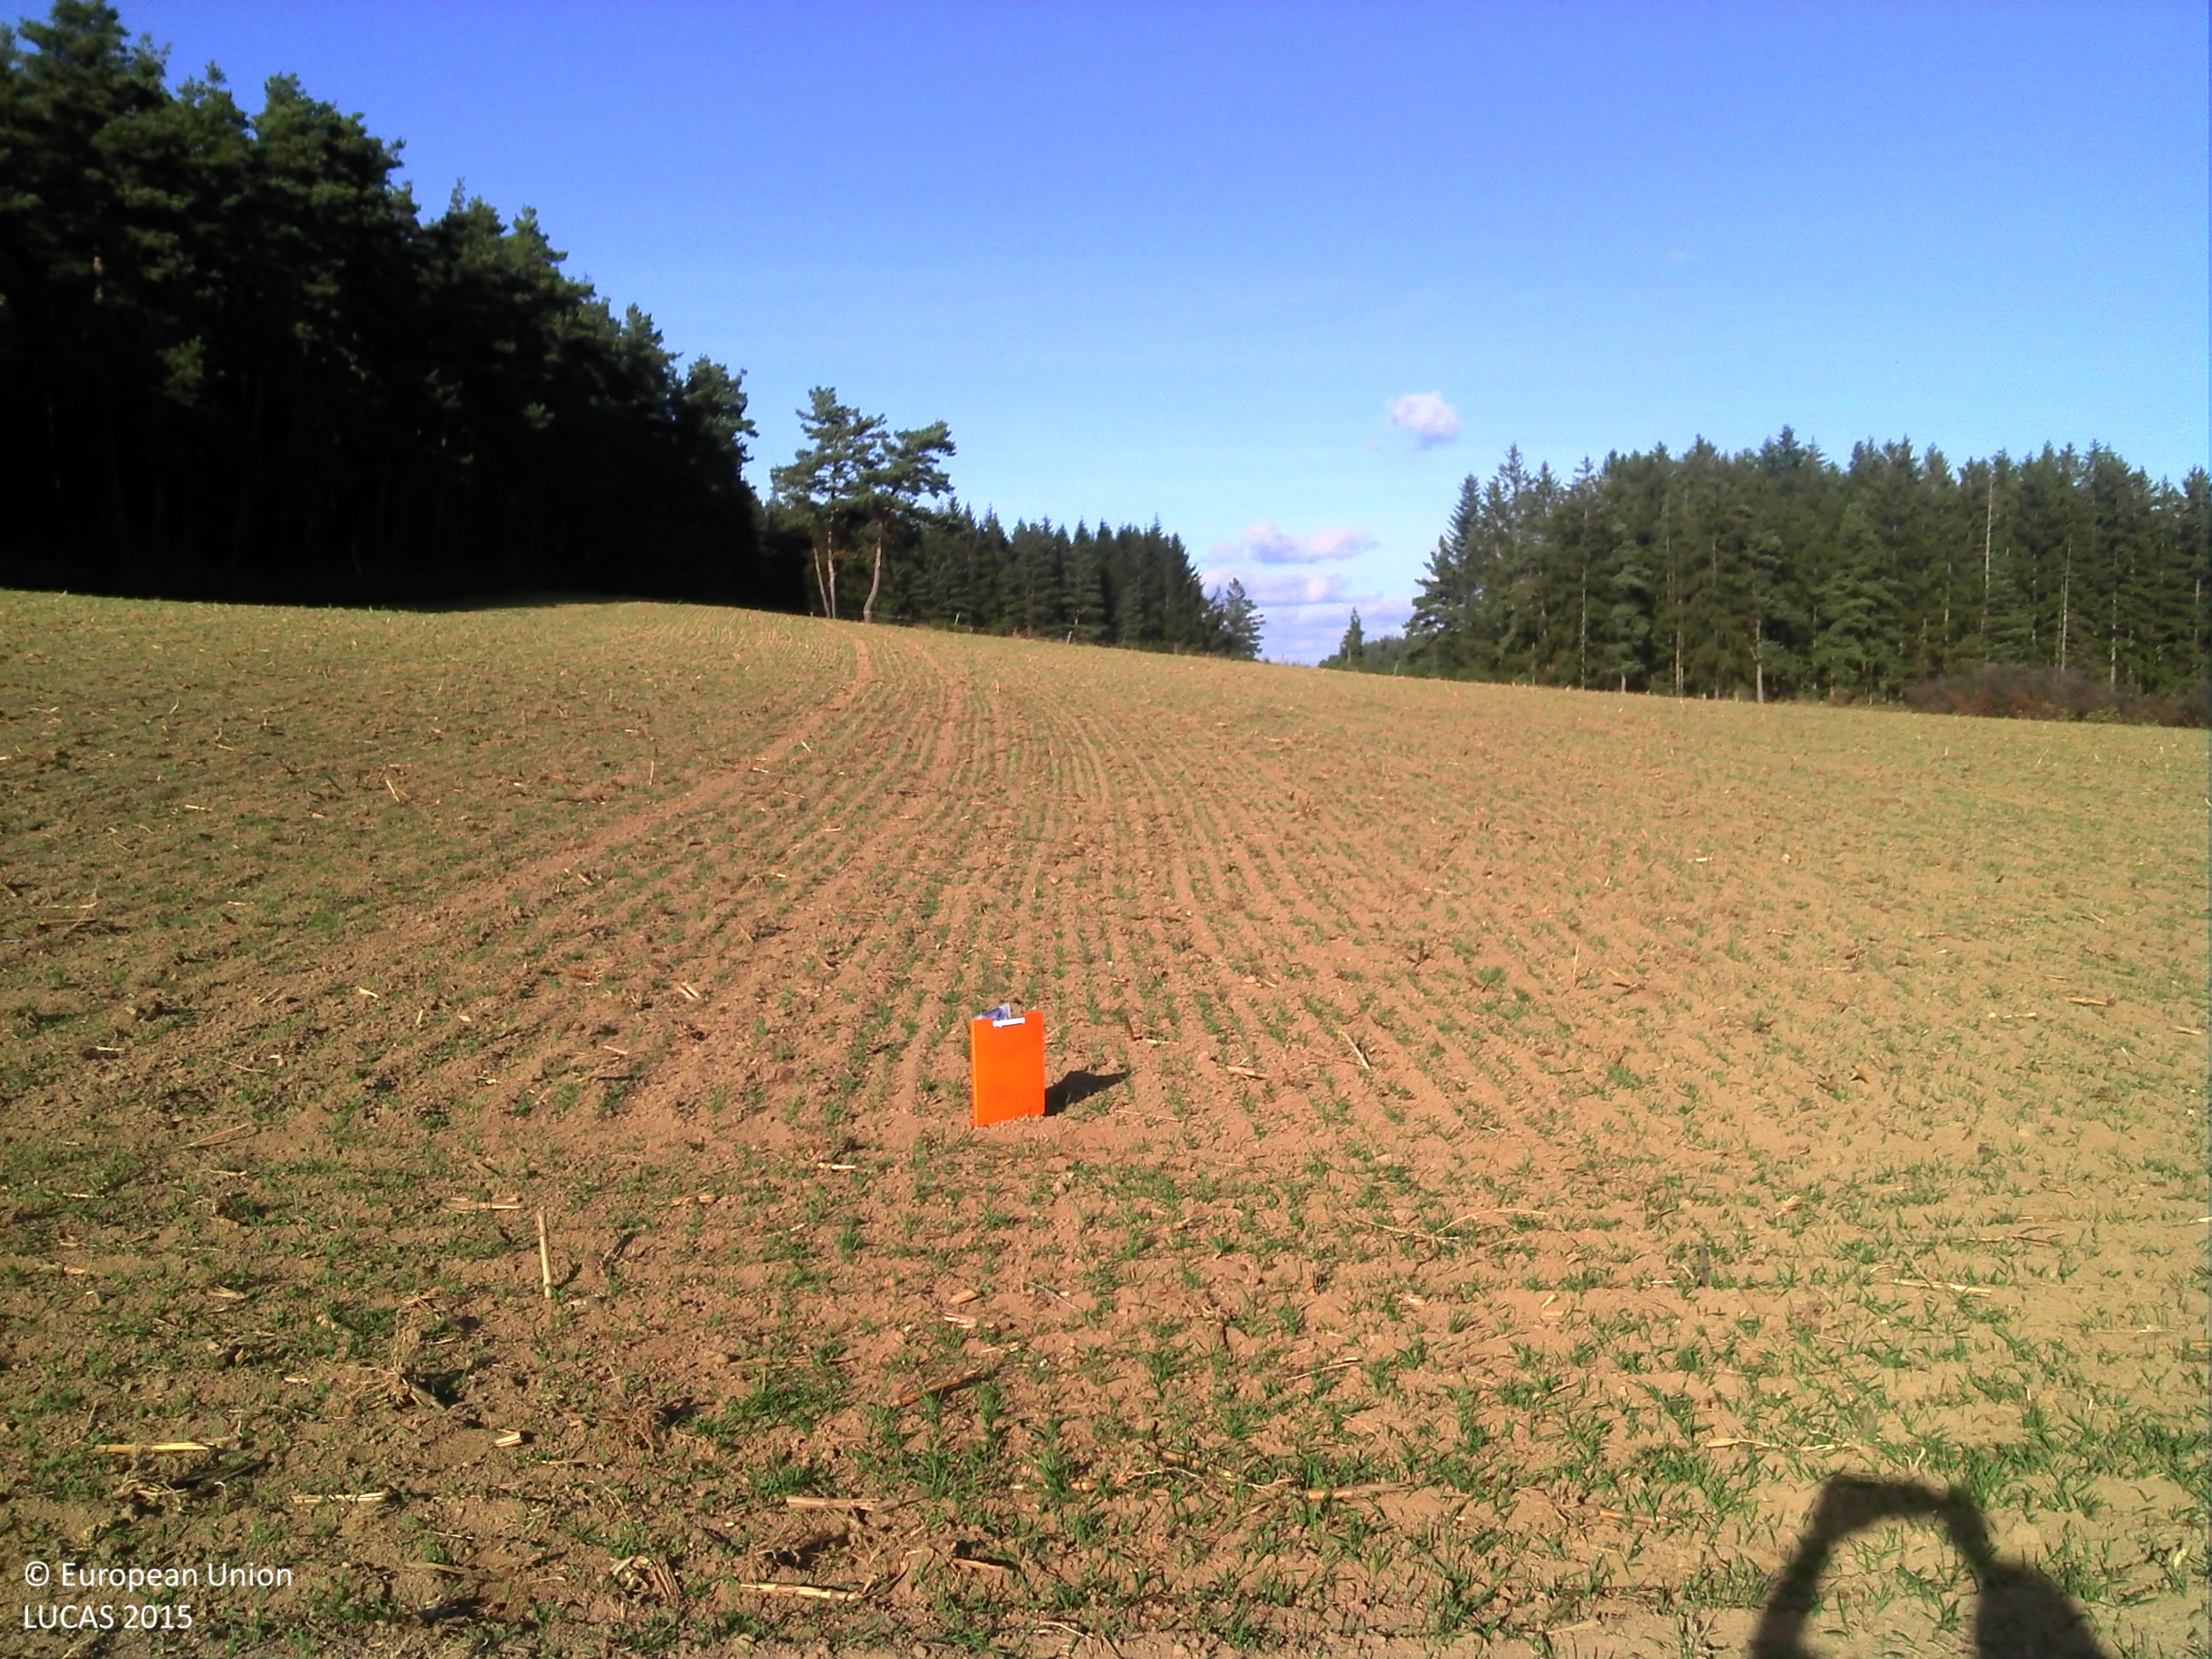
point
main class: Cropland
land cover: Temporary grasslands
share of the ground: 10 - 25 %
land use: Agriculture (excluding fallow land and kitchen gardens)
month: November
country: FR
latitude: 45.2498
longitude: 3.7983
